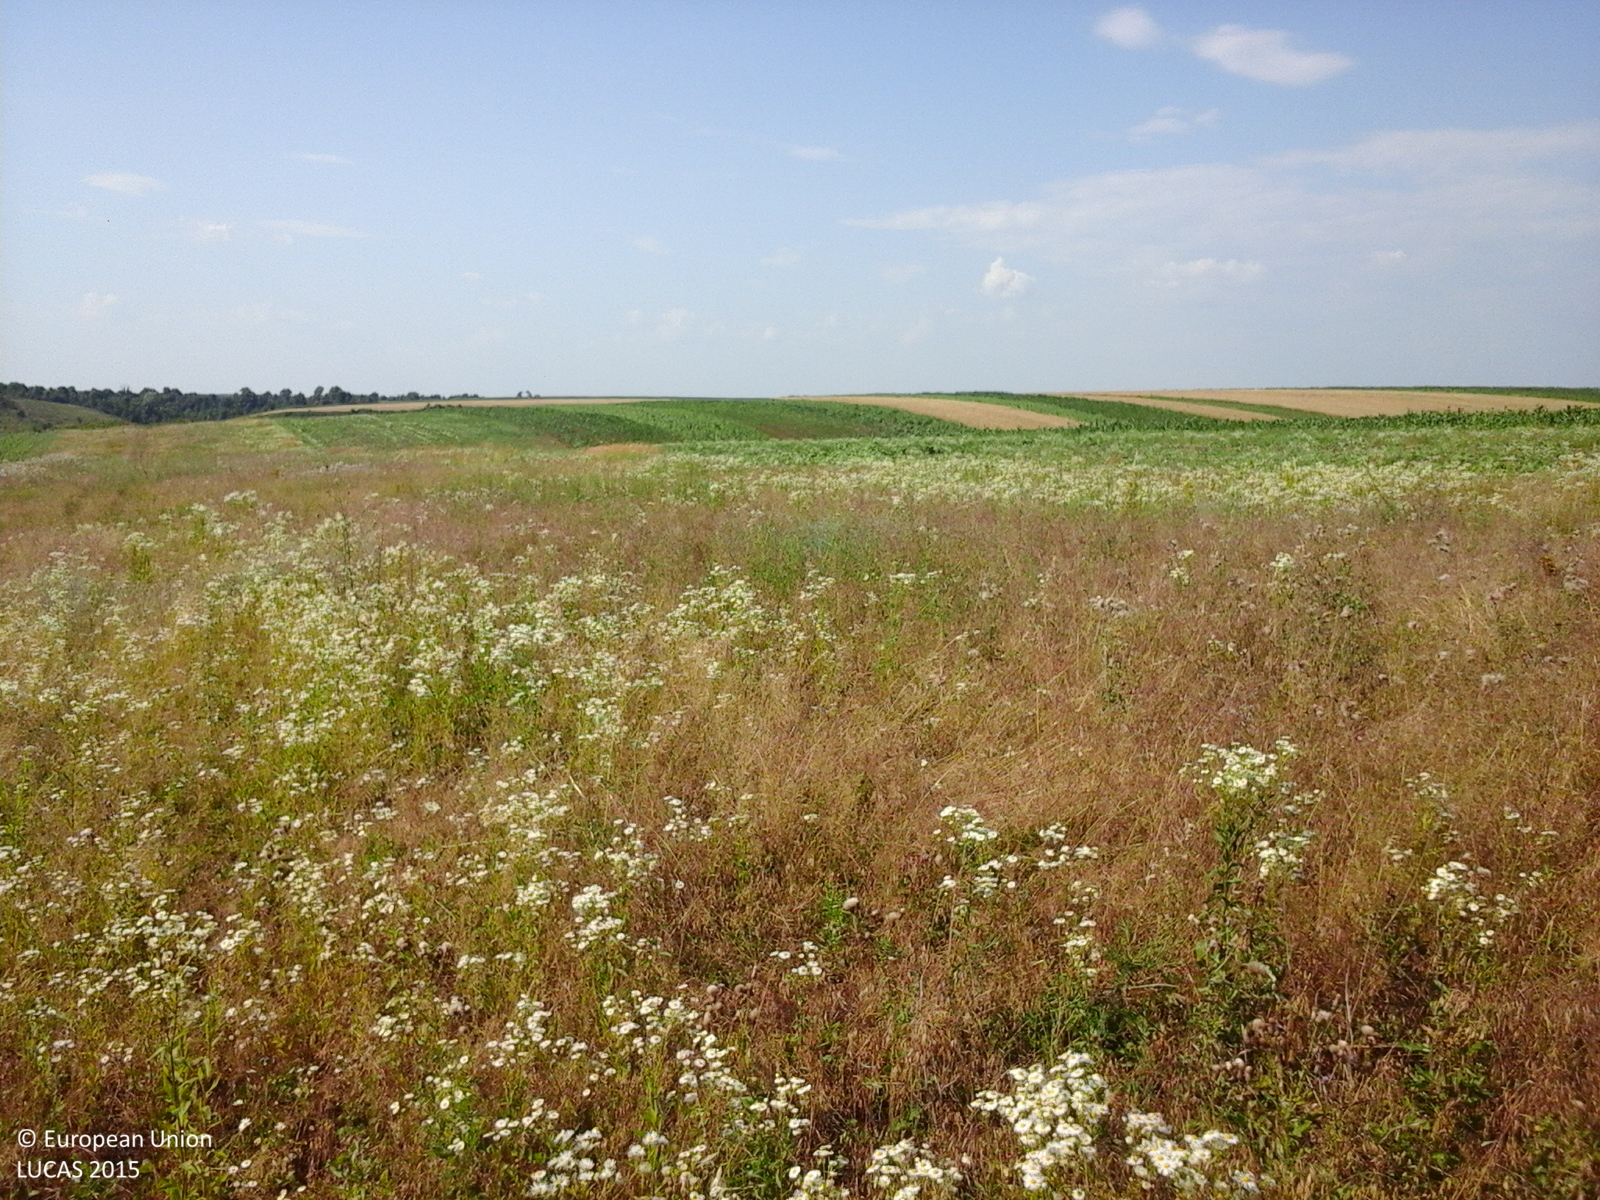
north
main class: Grassland
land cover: Spontaneously vegetated surfaces
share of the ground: > 75 %
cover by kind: herbaceous plants 100 %
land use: Fallow land
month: July
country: RO
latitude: 44.5294
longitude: 24.6585
